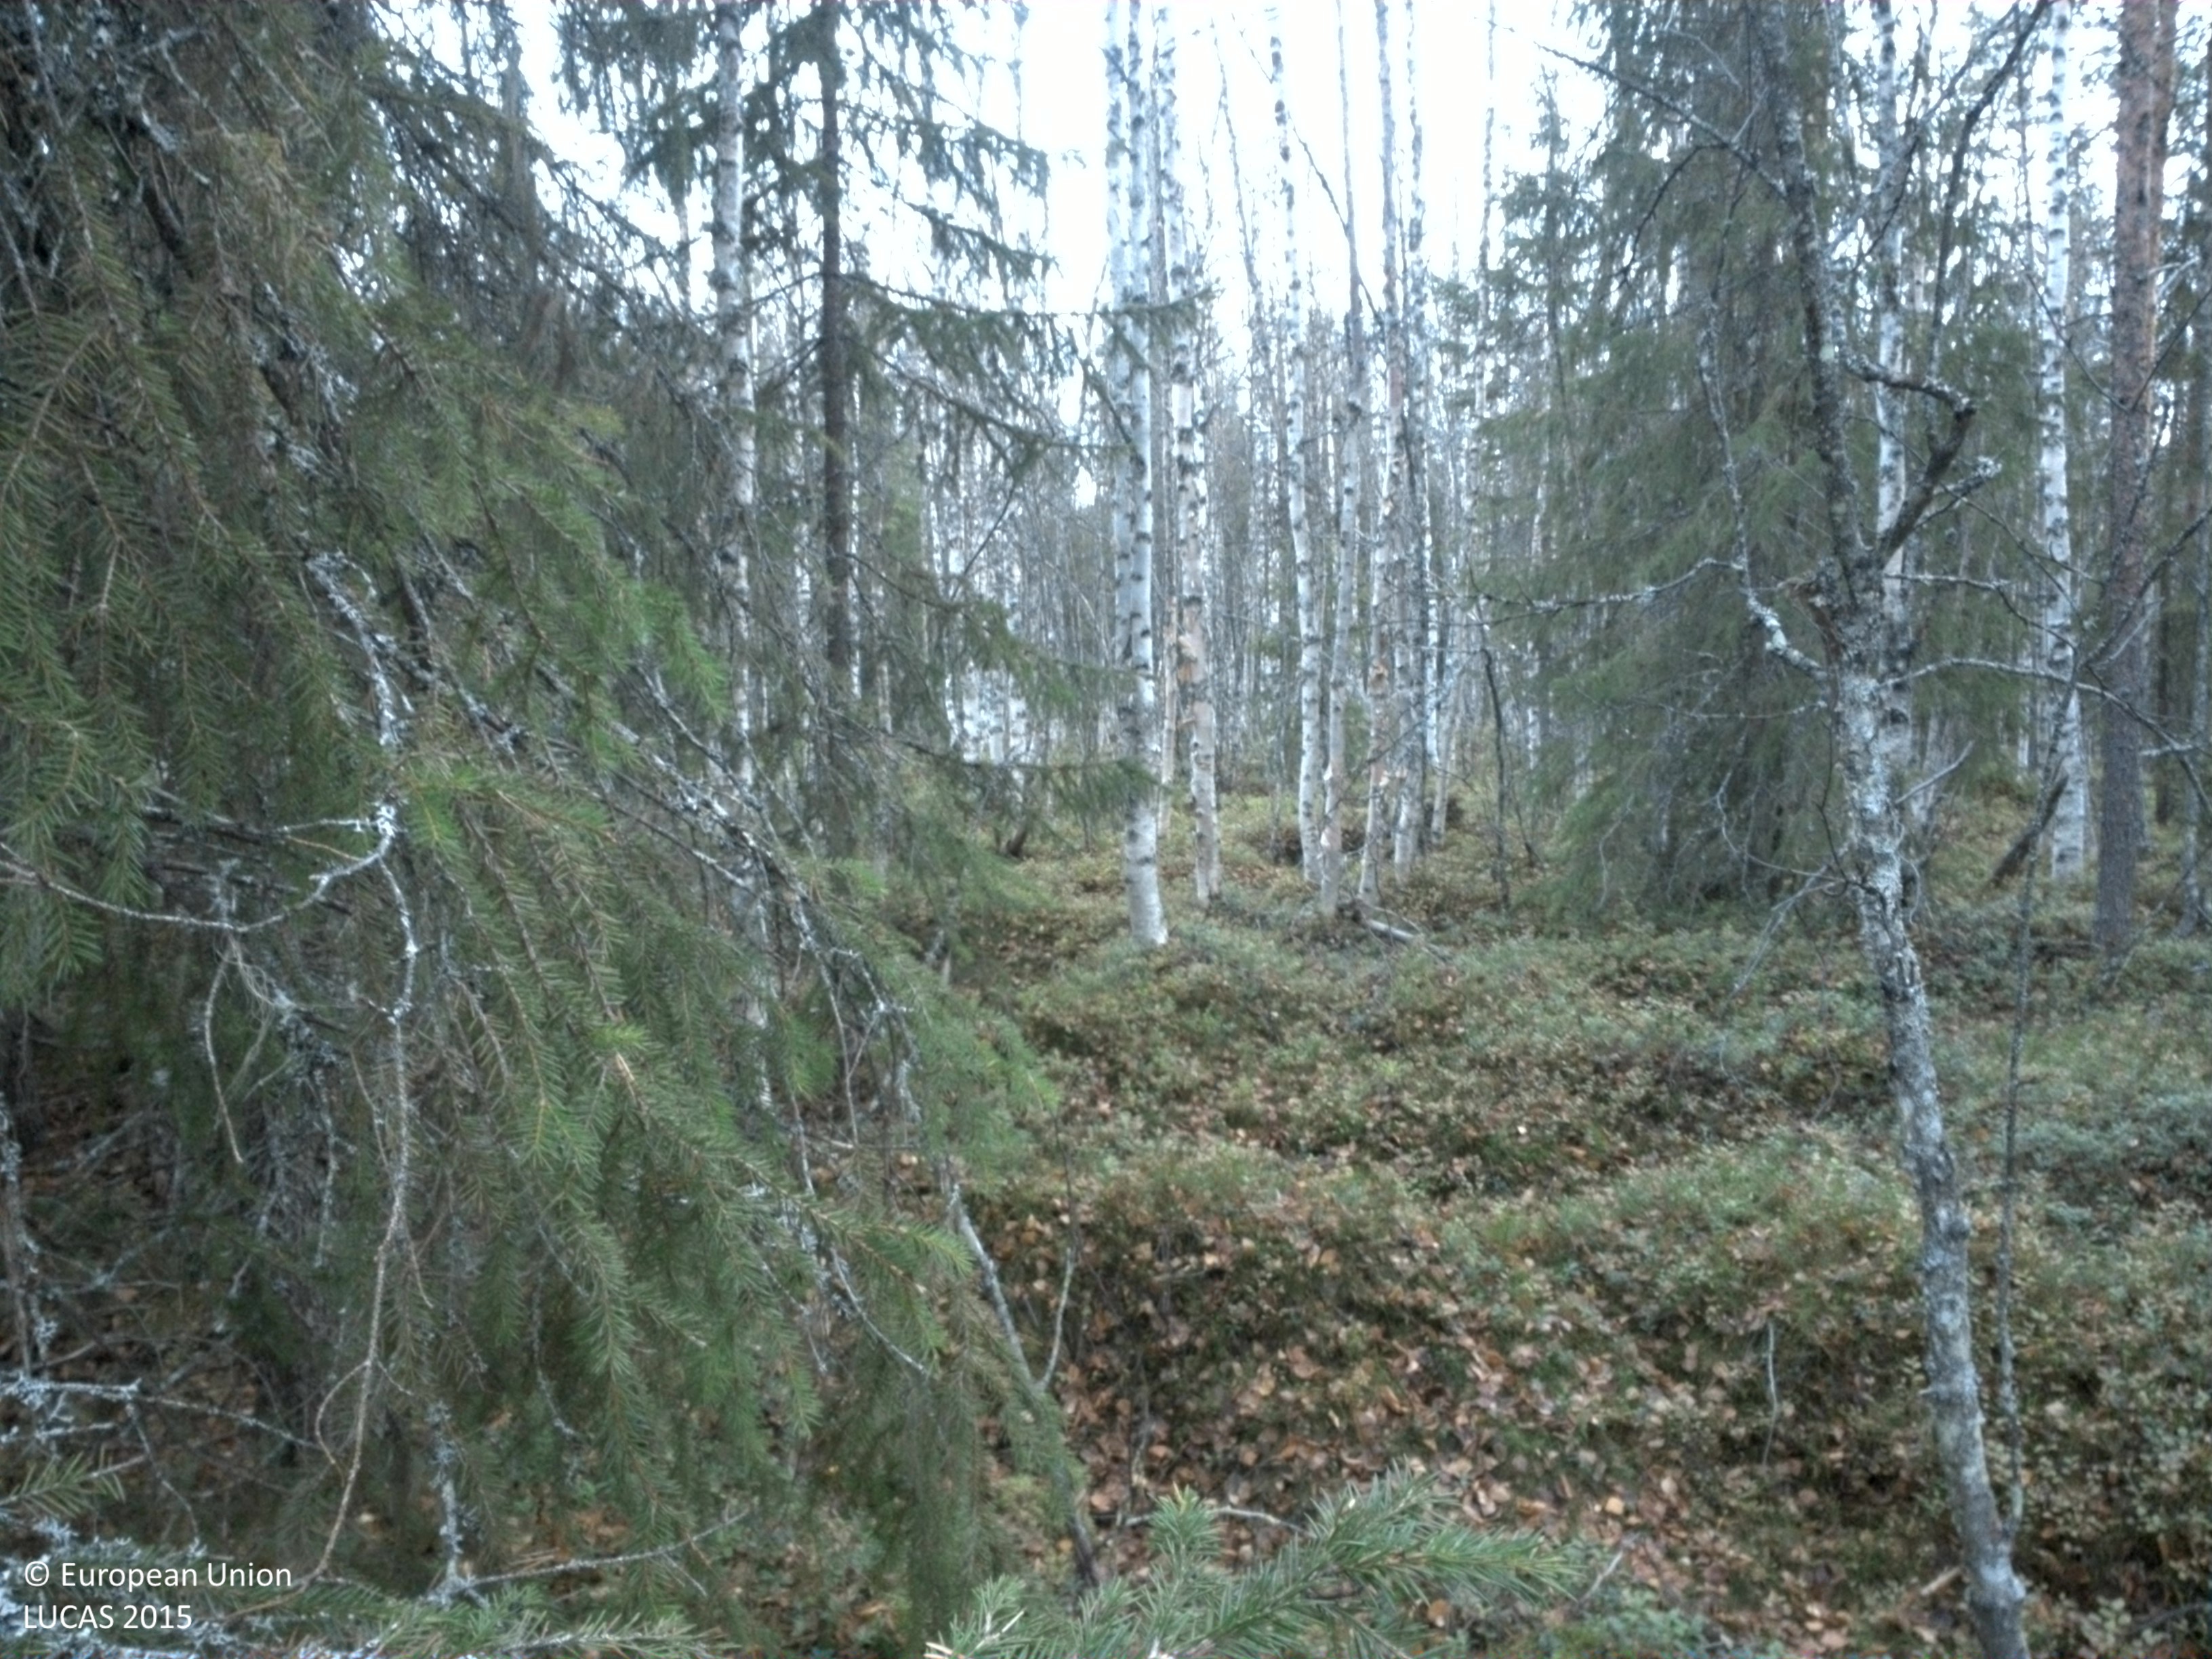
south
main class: Woodland
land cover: Other mixed woodland
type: boreal forest
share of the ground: 50 - 75 %
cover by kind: broadleaved forest trees 35 %, coniferous forest trees 25 %, shrubs 25 %, lichens and mosses 10 %, herbaceous plants 5 %
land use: Forestry
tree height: > 5 m
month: October
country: SE
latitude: 64.5927
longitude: 16.4639
